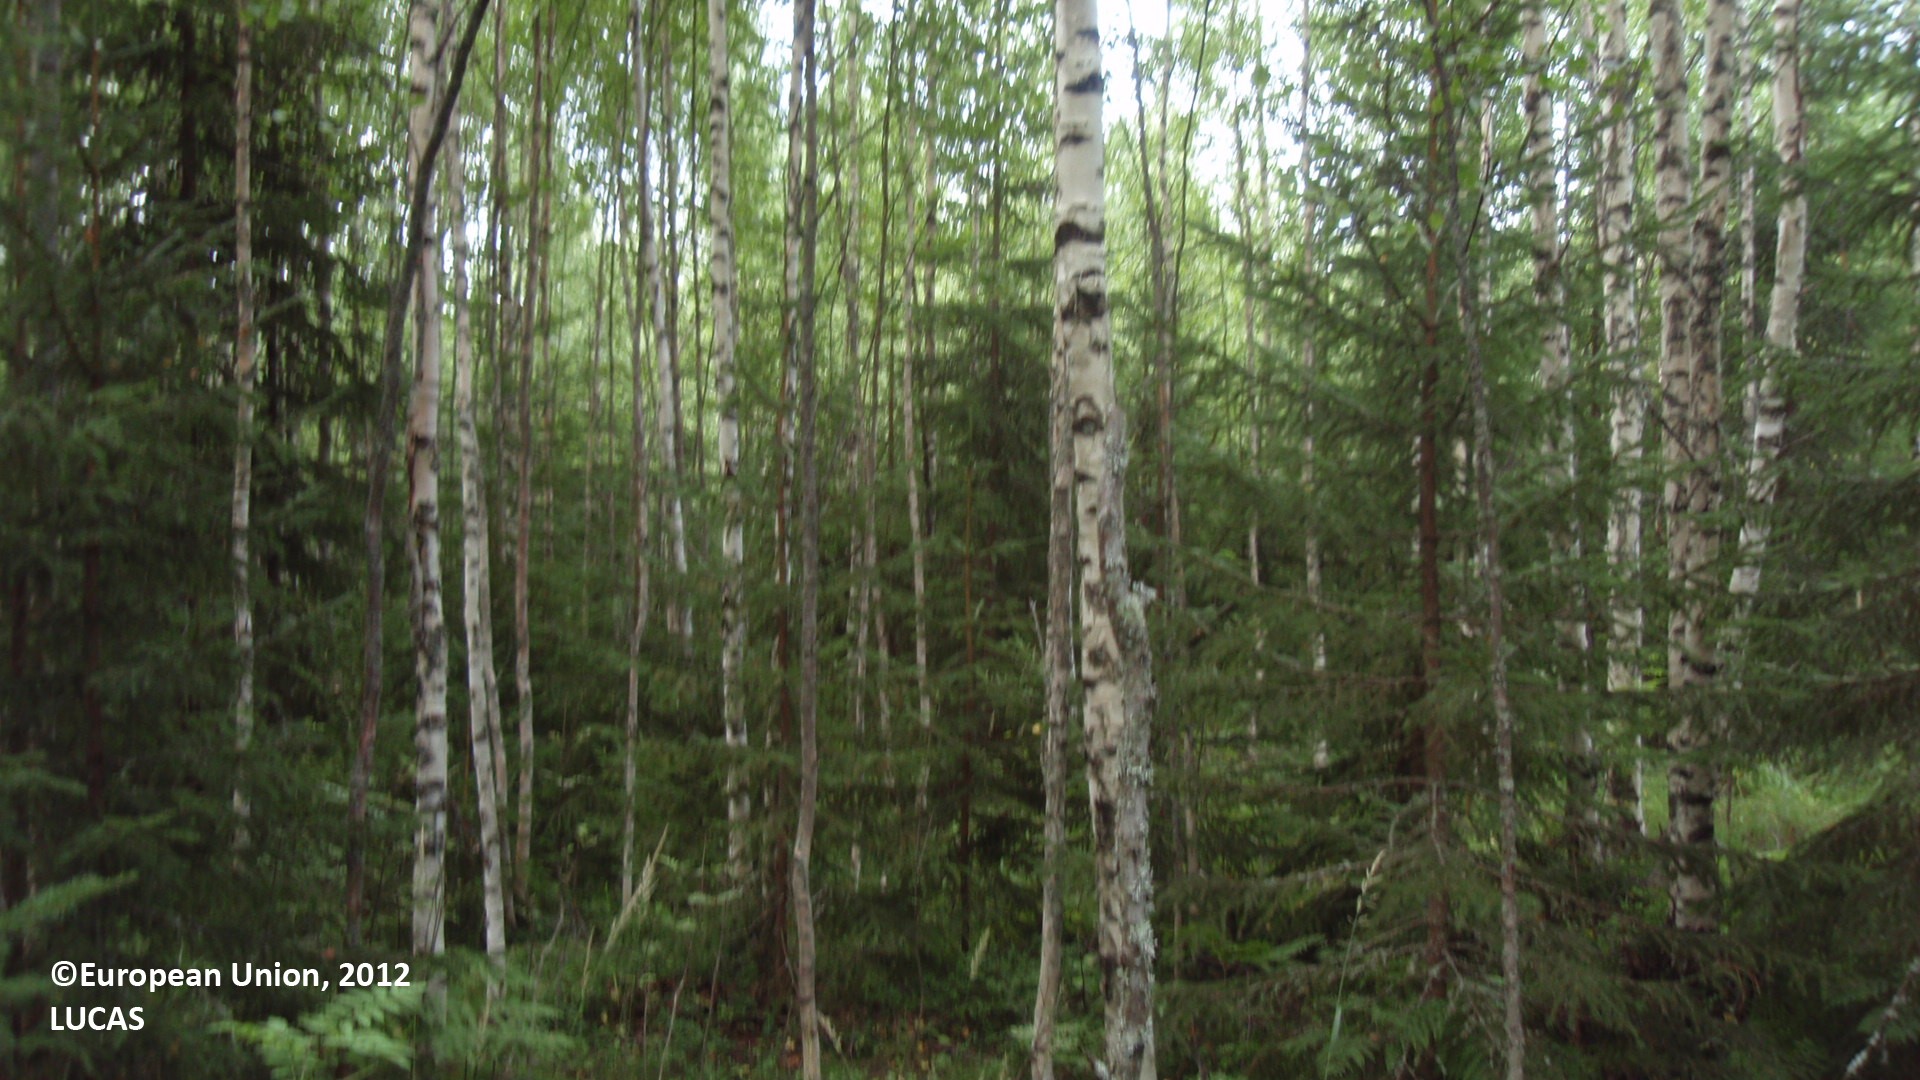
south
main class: Woodland
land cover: Spruce dominated mixed woodland
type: boreal forest
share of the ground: 50 - 75 %
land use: Forestry
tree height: > 5 m
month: August
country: FI
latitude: 60.9290
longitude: 27.3167
